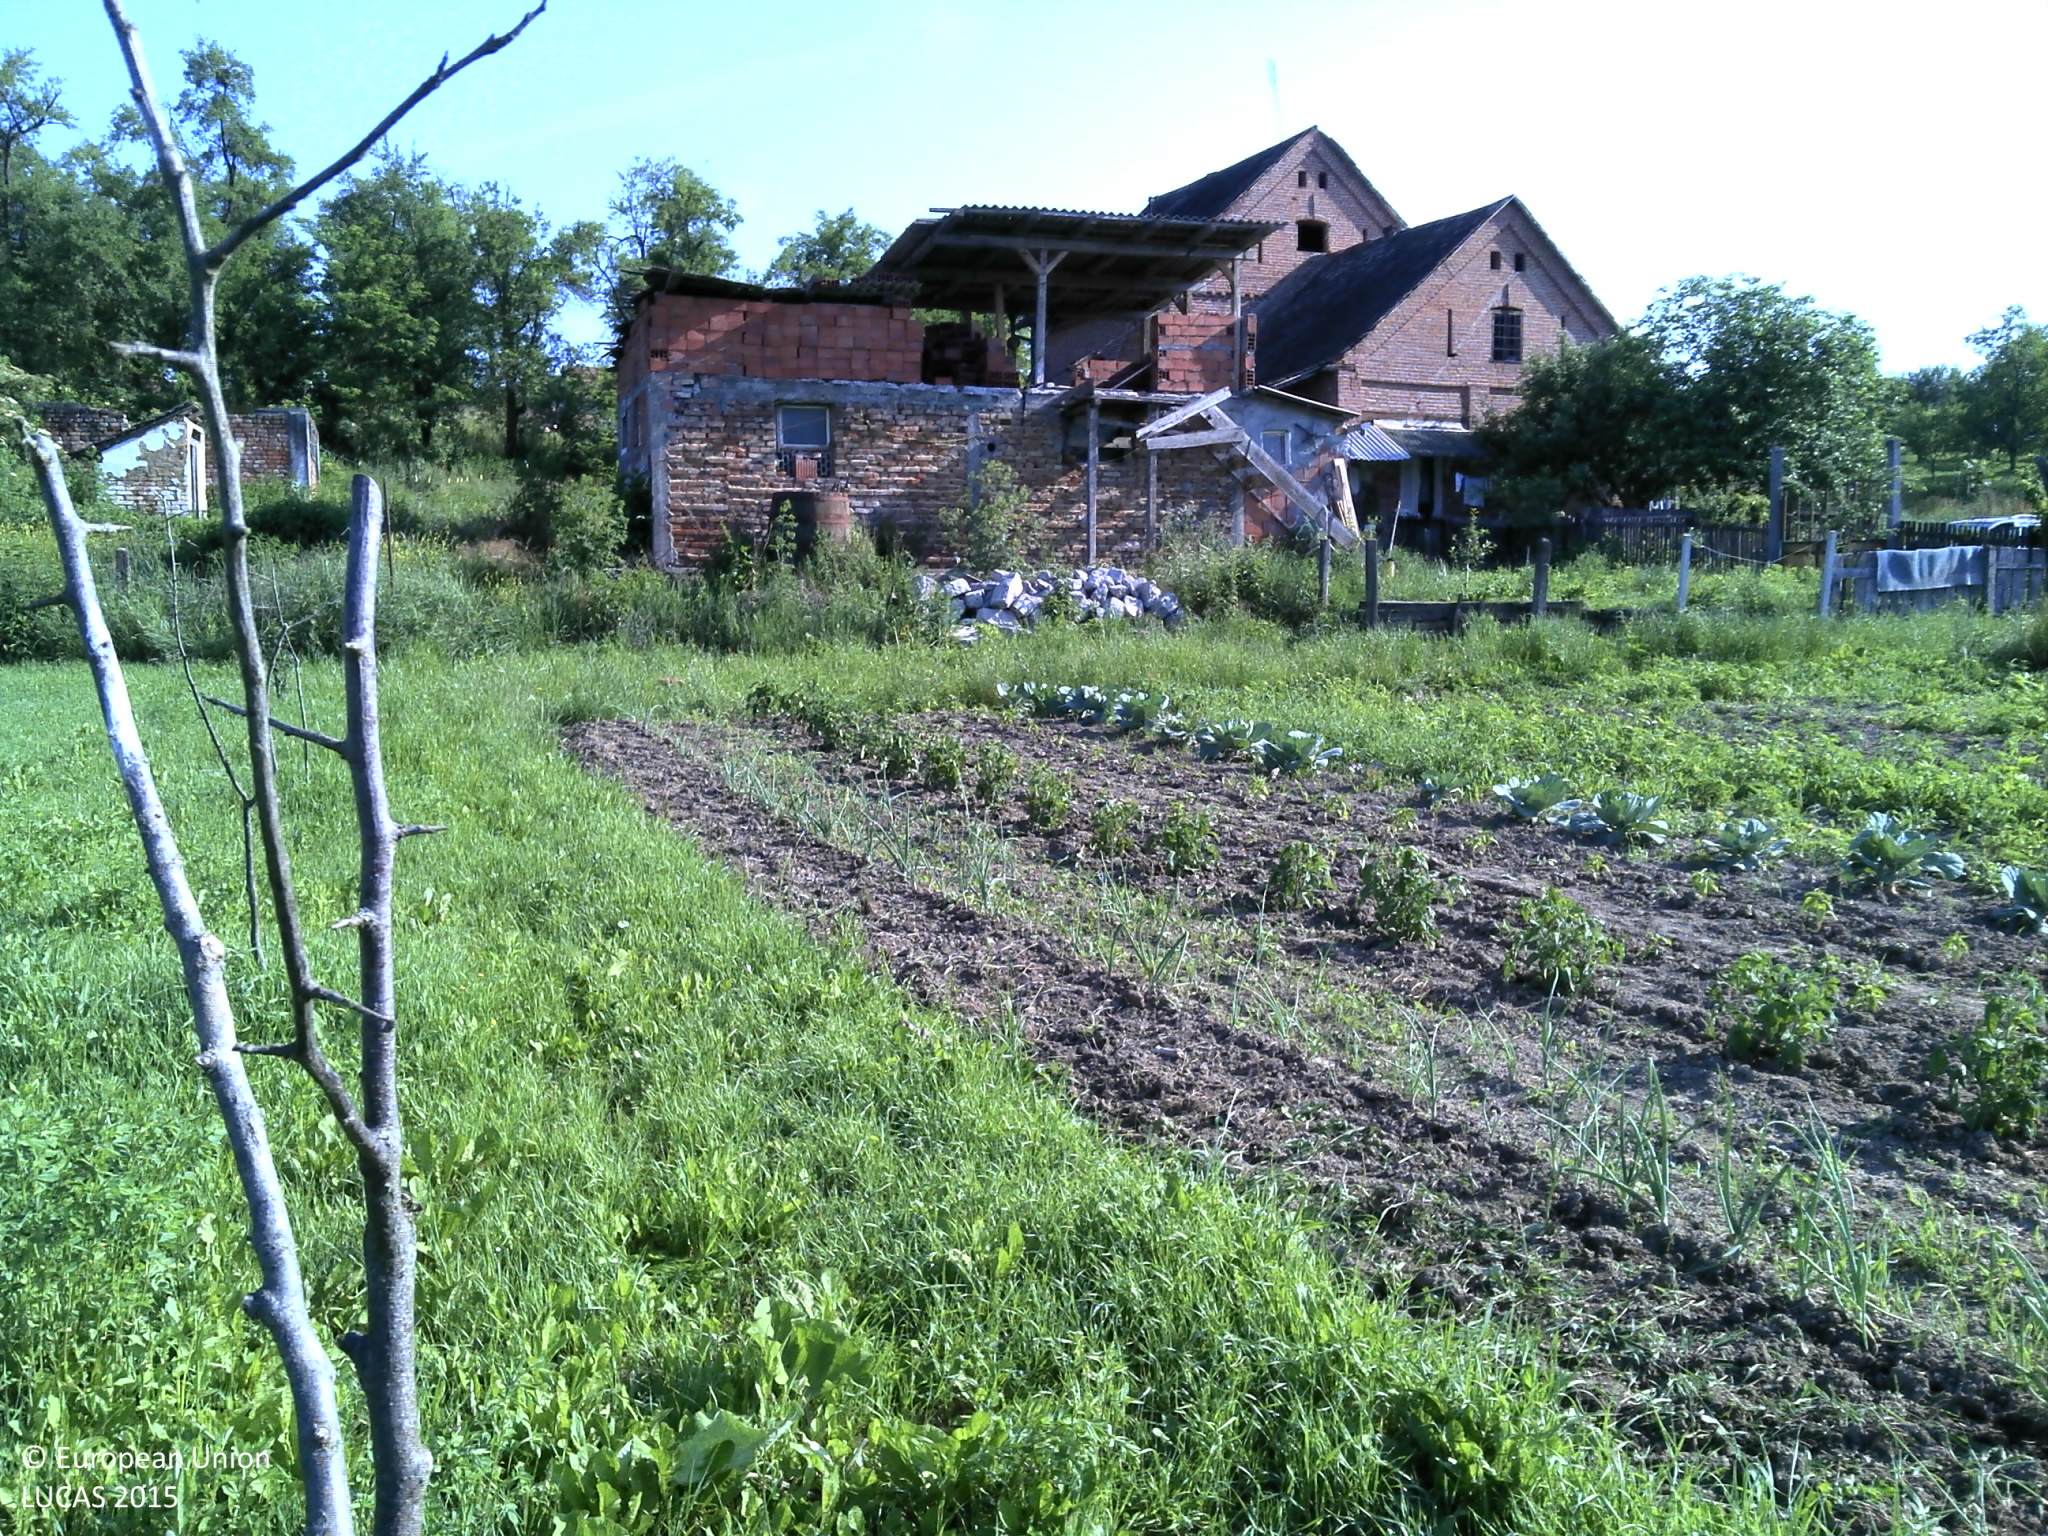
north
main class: Cropland
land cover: Other fruit trees and berries
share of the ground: < 10 %
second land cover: Grassland without tree/shrub cover
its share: > 75 %
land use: Kitchen garden
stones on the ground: < 10 %
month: June
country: HR
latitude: 45.3133
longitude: 18.1802
